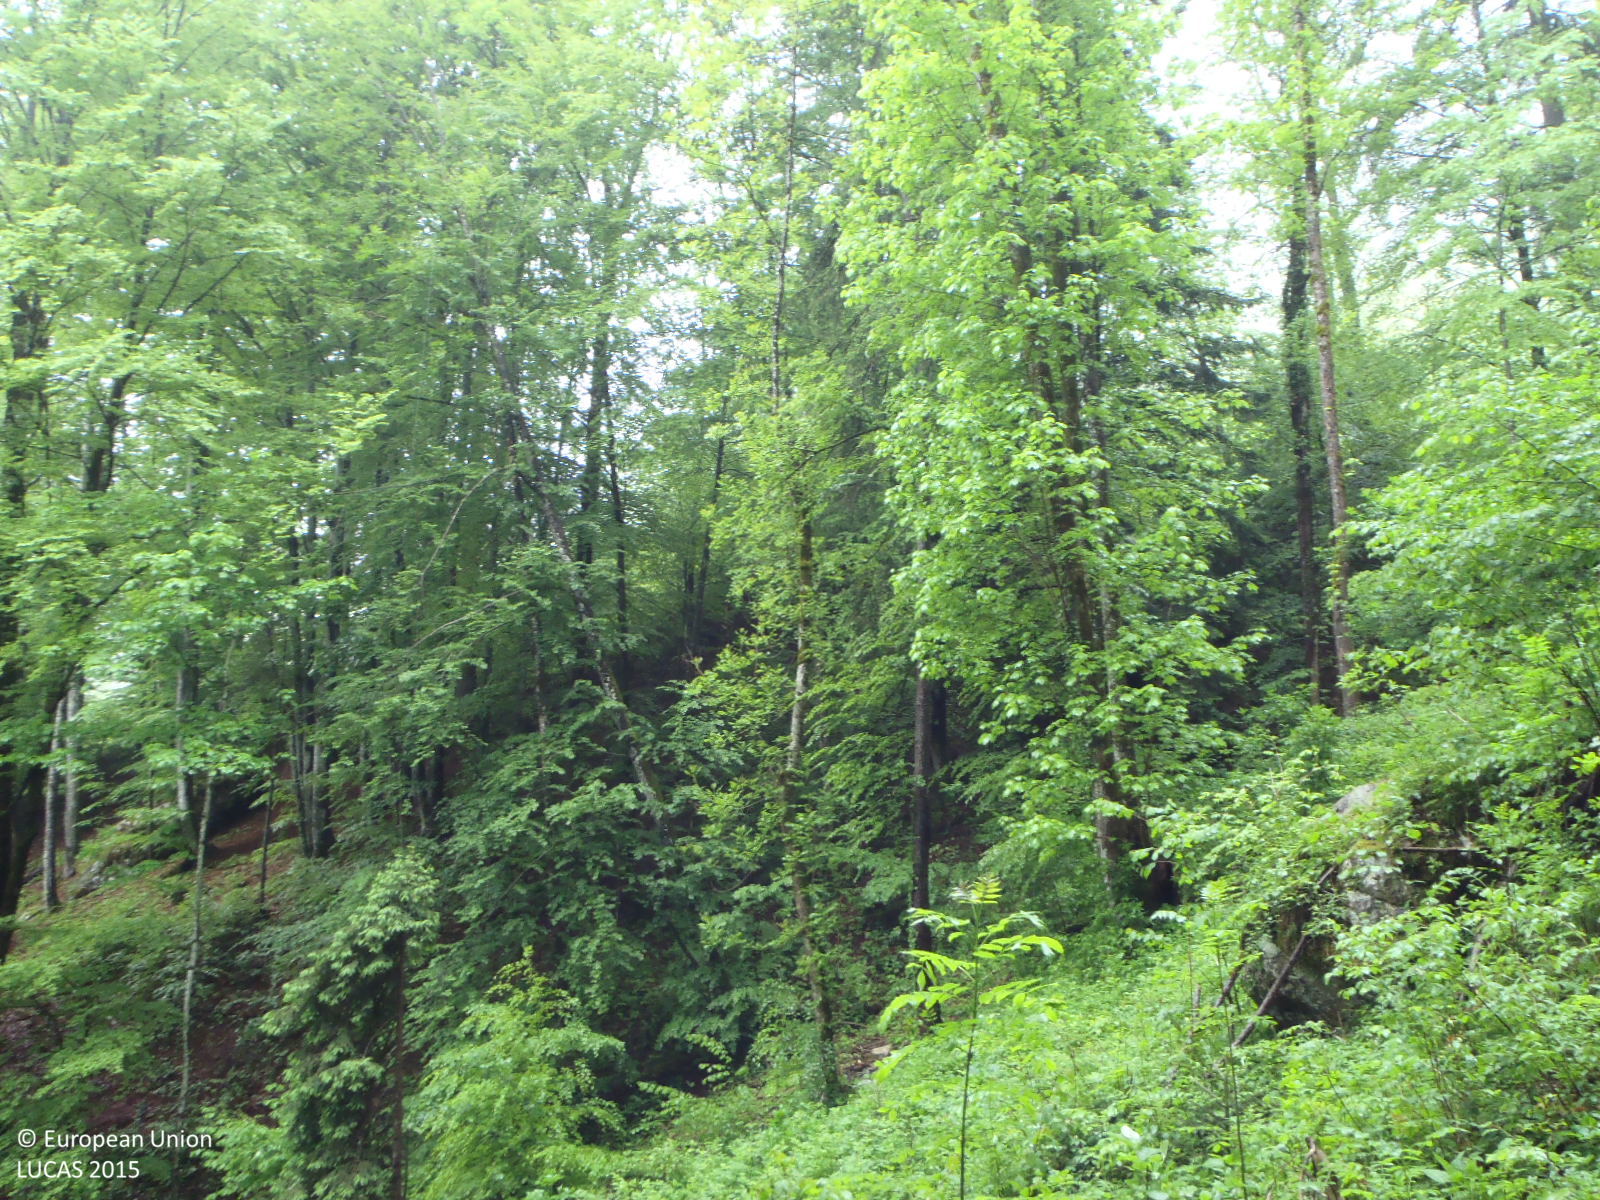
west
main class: Shrubland
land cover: Shrubland with sparse tree cover
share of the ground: > 75 %
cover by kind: herbaceous plants 55 %, shrubs 25 %, lichens and mosses 10 %, broadleaved forest trees 5 %, unconsolidated bare surface 5 %
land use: Forestry
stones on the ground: < 10 %
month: May
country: AT
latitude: 47.6503
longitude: 12.7010
